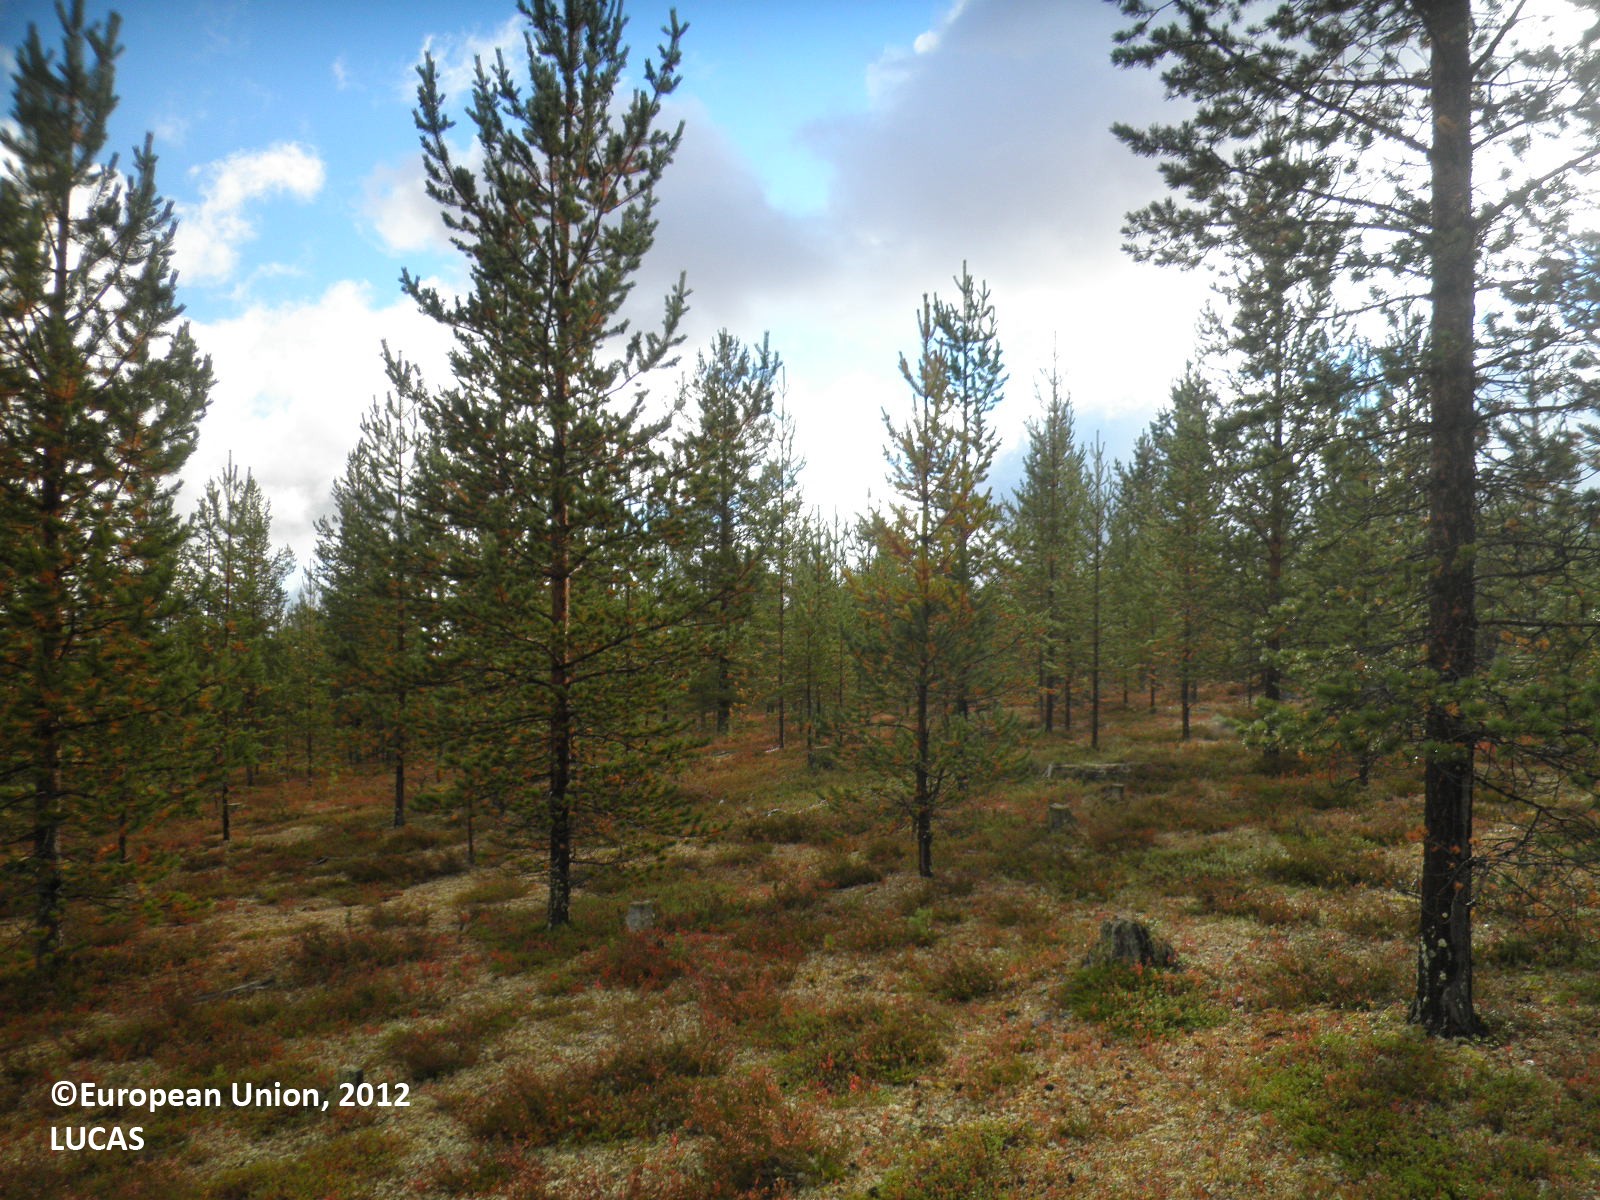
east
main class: Woodland
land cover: Pine dominated coniferous woodland
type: boreal forest
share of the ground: 10 - 25 %
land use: Forestry
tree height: > 5 m
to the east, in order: Pine dominated coniferous woodland
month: September
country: FI
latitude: 67.4622
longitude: 28.3846
